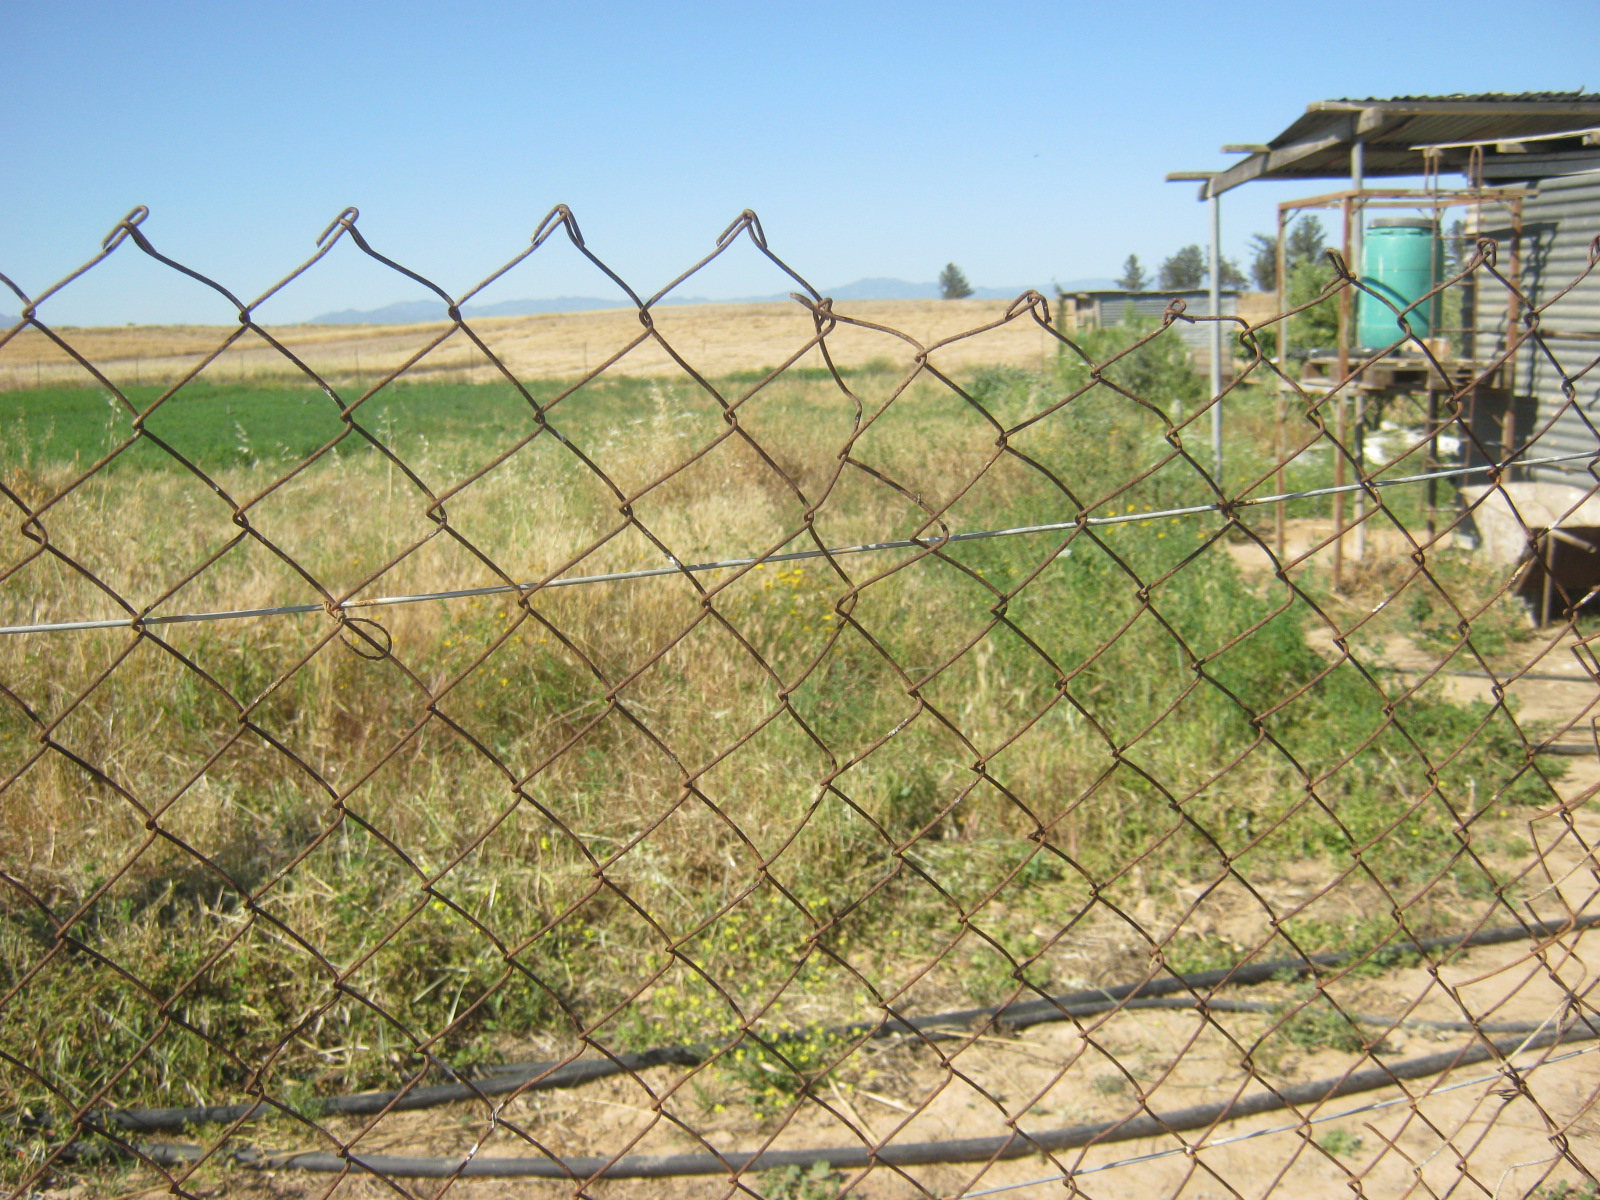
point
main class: Grassland
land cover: Spontaneously vegetated surfaces
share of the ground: > 75 %
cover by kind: herbaceous plants 90 %, unconsolidated bare surface 10 %
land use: Agriculture (excluding fallow land and kitchen gardens)
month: May
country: CY
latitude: 35.1601
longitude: 33.2545
